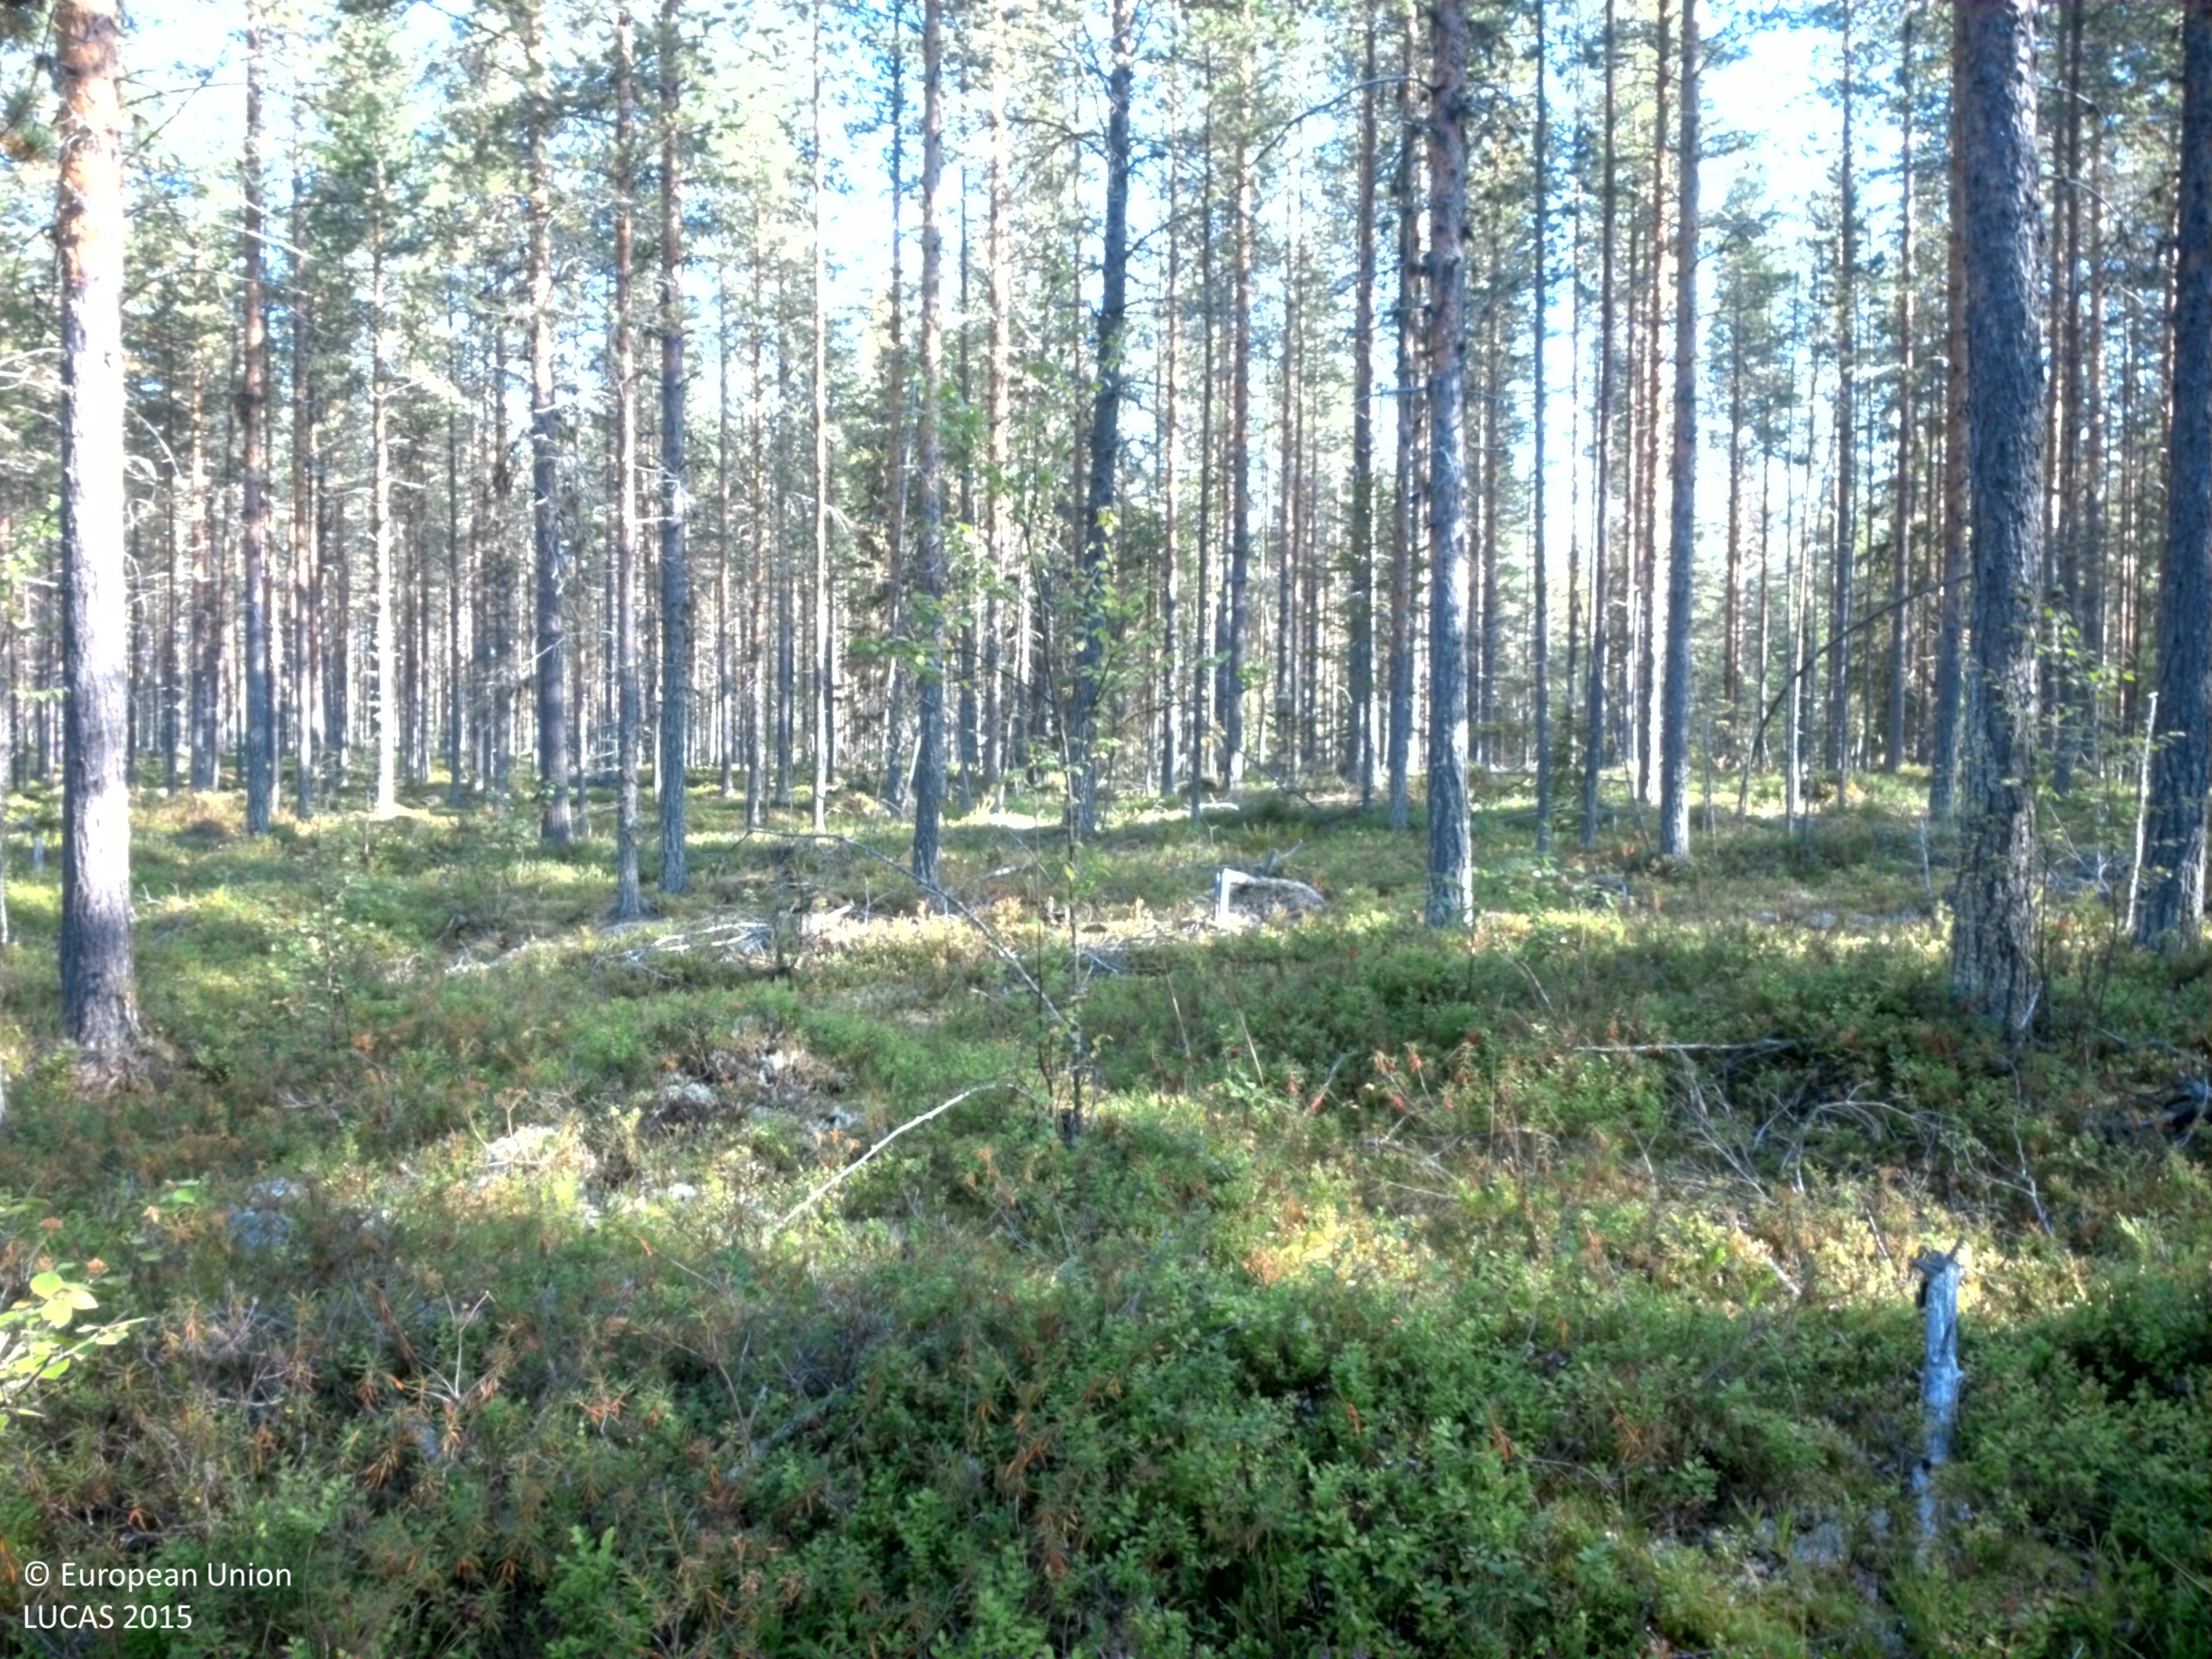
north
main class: Woodland
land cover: Pine dominated mixed woodland
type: boreal forest
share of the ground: 50 - 75 %
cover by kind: coniferous forest trees 45 %, shrubs 35 %, broadleaved forest trees 15 %, lichens and mosses 5 %
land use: Forestry
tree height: > 5 m
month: August
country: SE
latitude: 64.5542
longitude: 18.7923
